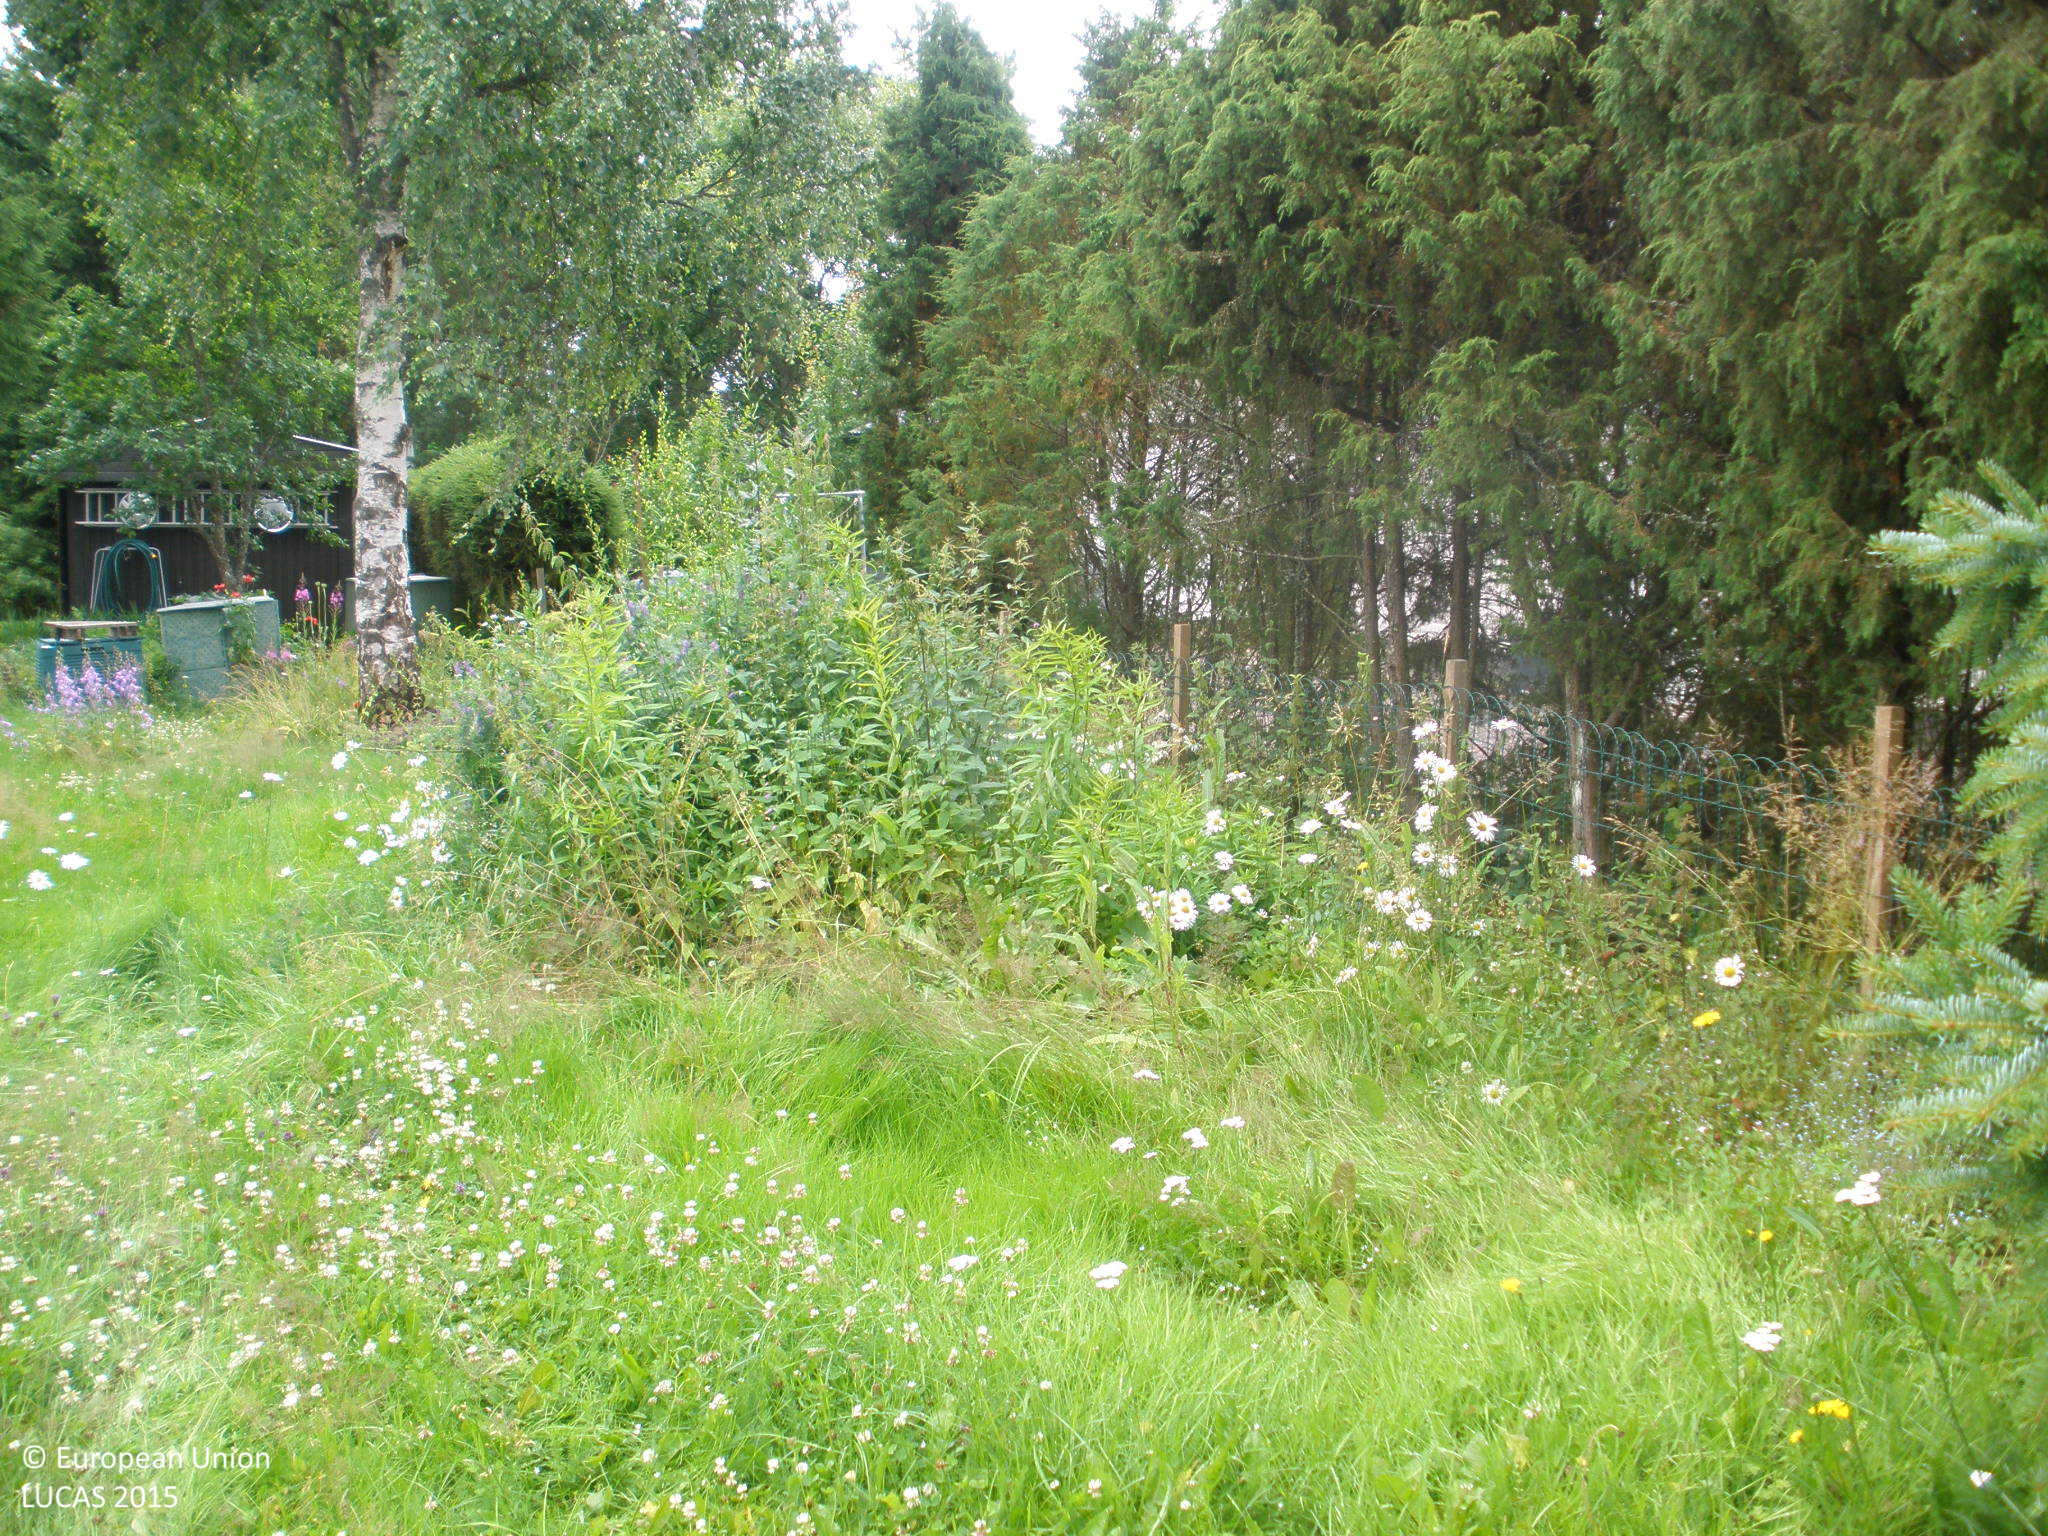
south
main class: Grassland
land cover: Grassland with sparse tree/shrub cover
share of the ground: > 75 %
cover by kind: herbaceous plants 95 %, broadleaved forest trees 5 %
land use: Residential
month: July
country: FI
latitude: 60.6243
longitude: 23.5187
